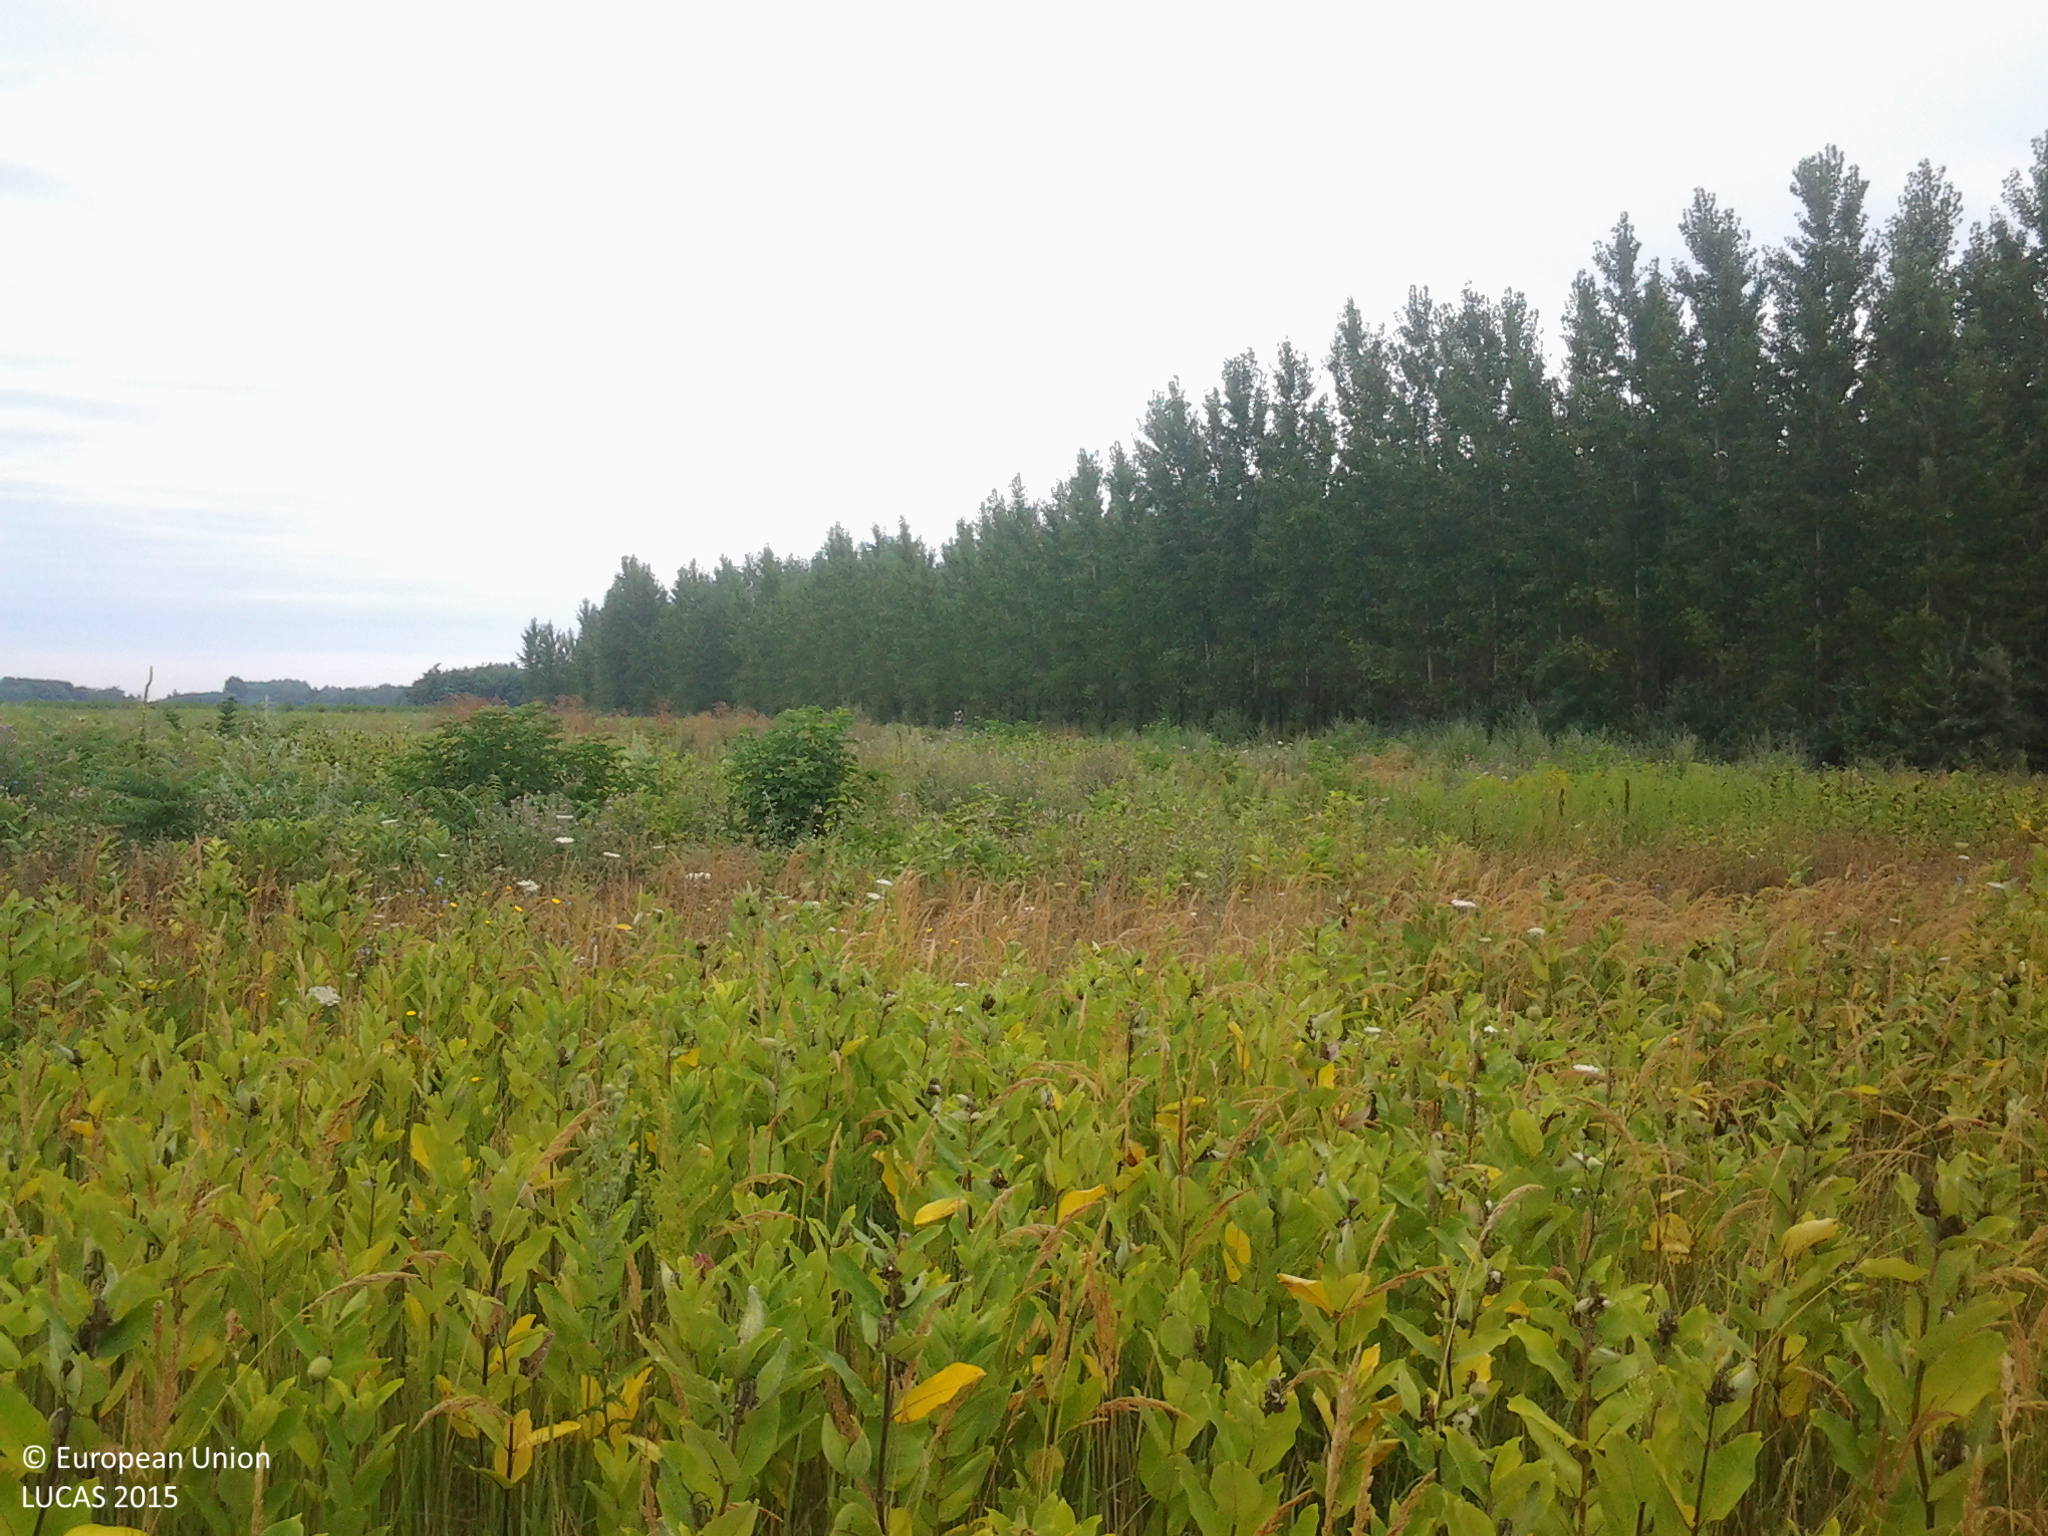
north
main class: Grassland
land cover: Spontaneously vegetated surfaces
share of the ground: > 75 %
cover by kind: herbaceous plants 100 %
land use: Semi-natural and natural areas not in use
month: July
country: HU
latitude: 46.9282
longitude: 19.2501
